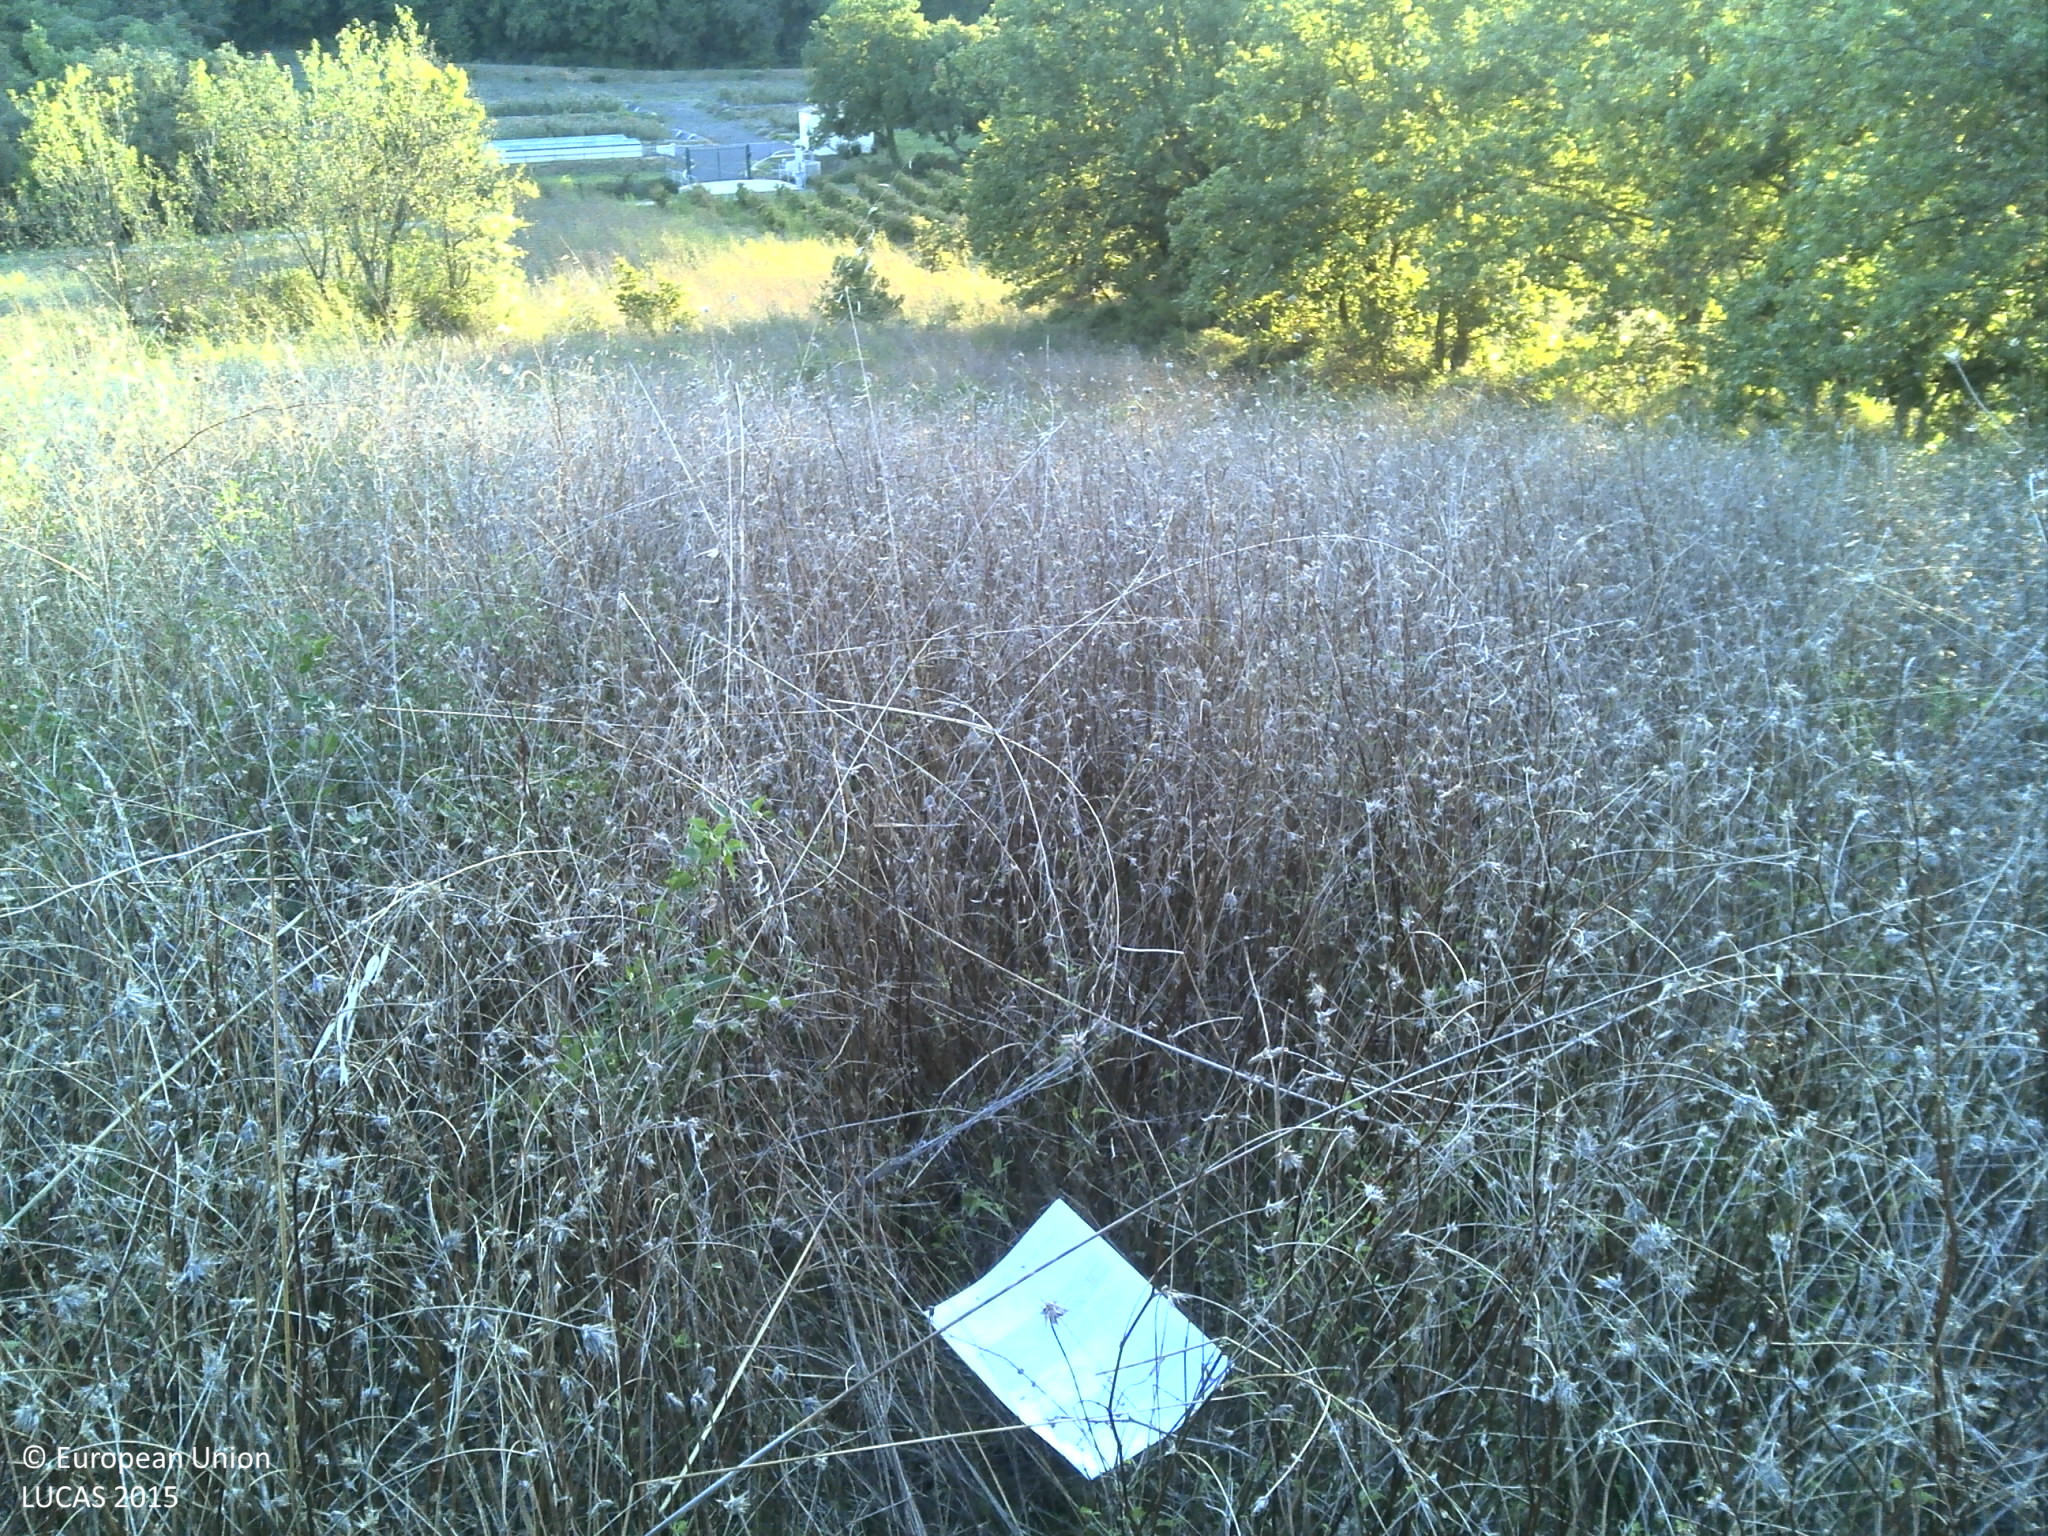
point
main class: Grassland
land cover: Spontaneously vegetated surfaces
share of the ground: > 75 %
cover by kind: herbaceous plants 95 %, shrubs 5 %
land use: Abandoned areas
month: October
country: FR
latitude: 43.5080
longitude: 3.4163
